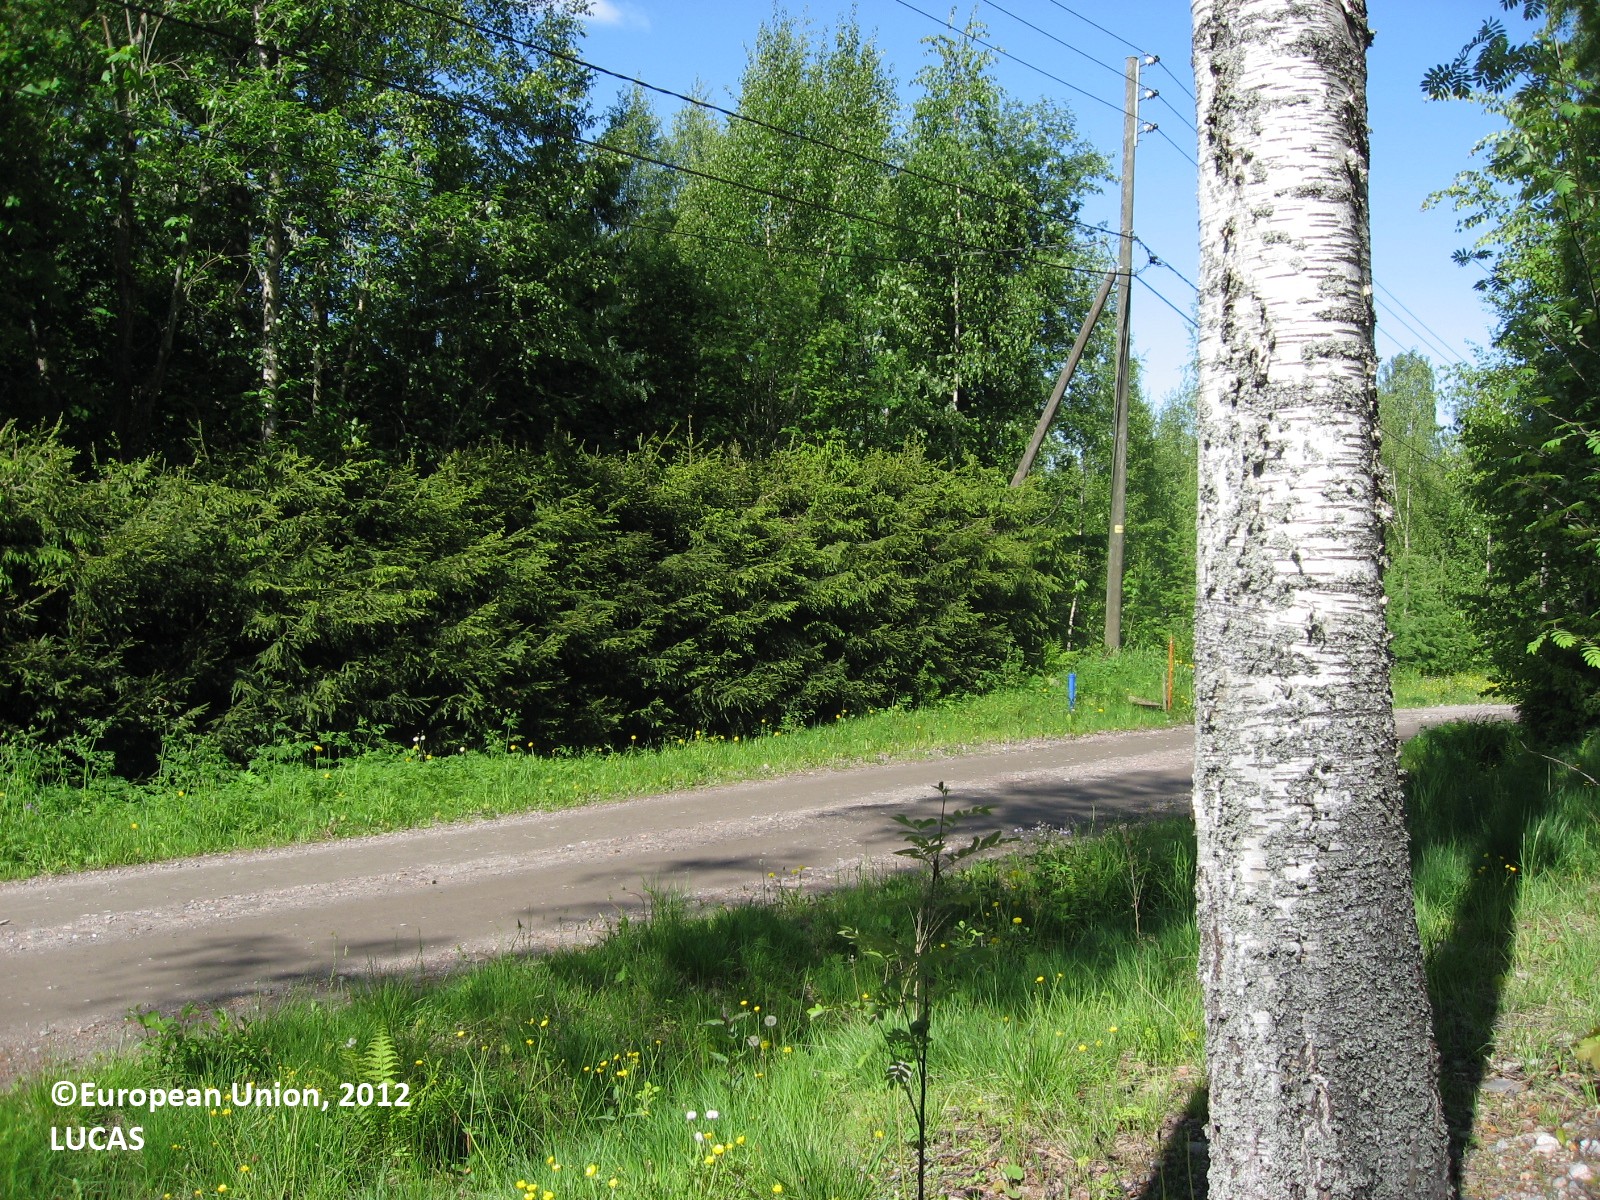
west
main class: Woodland
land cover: Broadleaved woodland
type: boreal forest
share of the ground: > 75 %
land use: Forestry
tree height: > 5 m
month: June
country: FI
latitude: 60.3644
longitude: 25.3374
